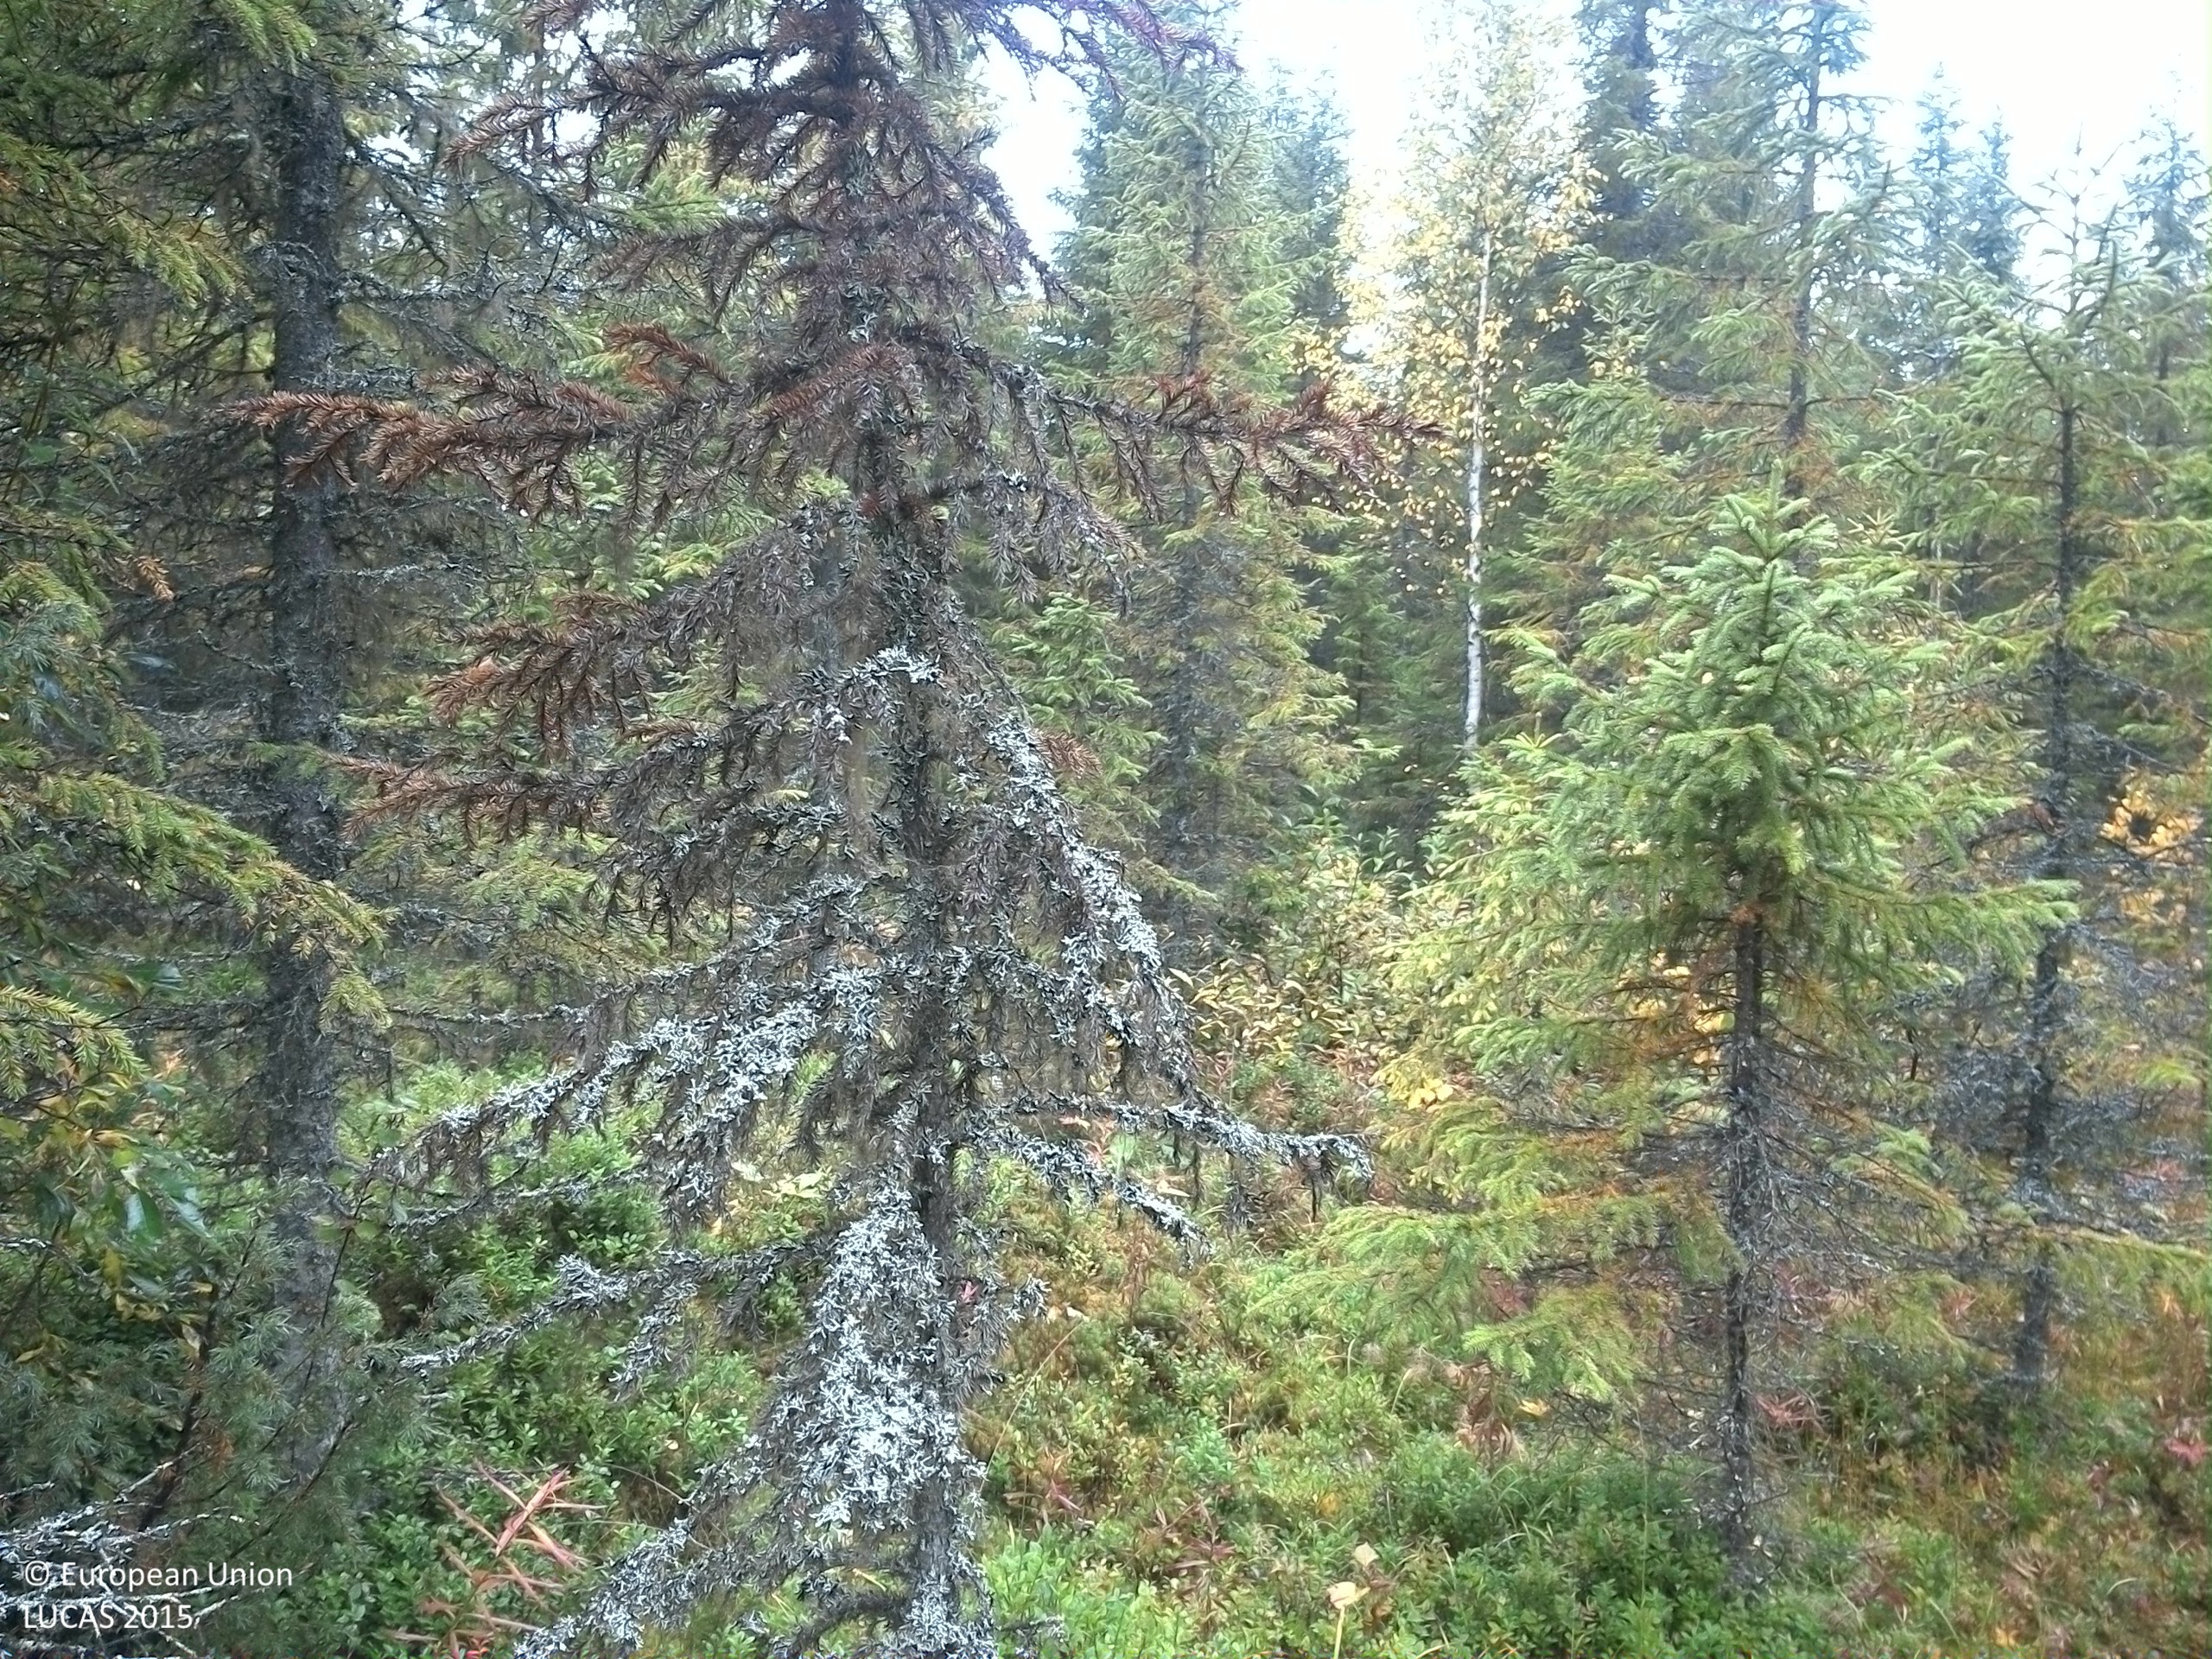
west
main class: Woodland
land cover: Spruce dominated coniferous woodland
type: boreal forest
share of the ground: 50 - 75 %
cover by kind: coniferous forest trees 60 %, shrubs 20 %, lichens and mosses 10 %, broadleaved forest trees 5 %, herbaceous plants 5 %
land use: Forestry
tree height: > 5 m
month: September
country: SE
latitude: 63.6206
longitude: 15.8442
